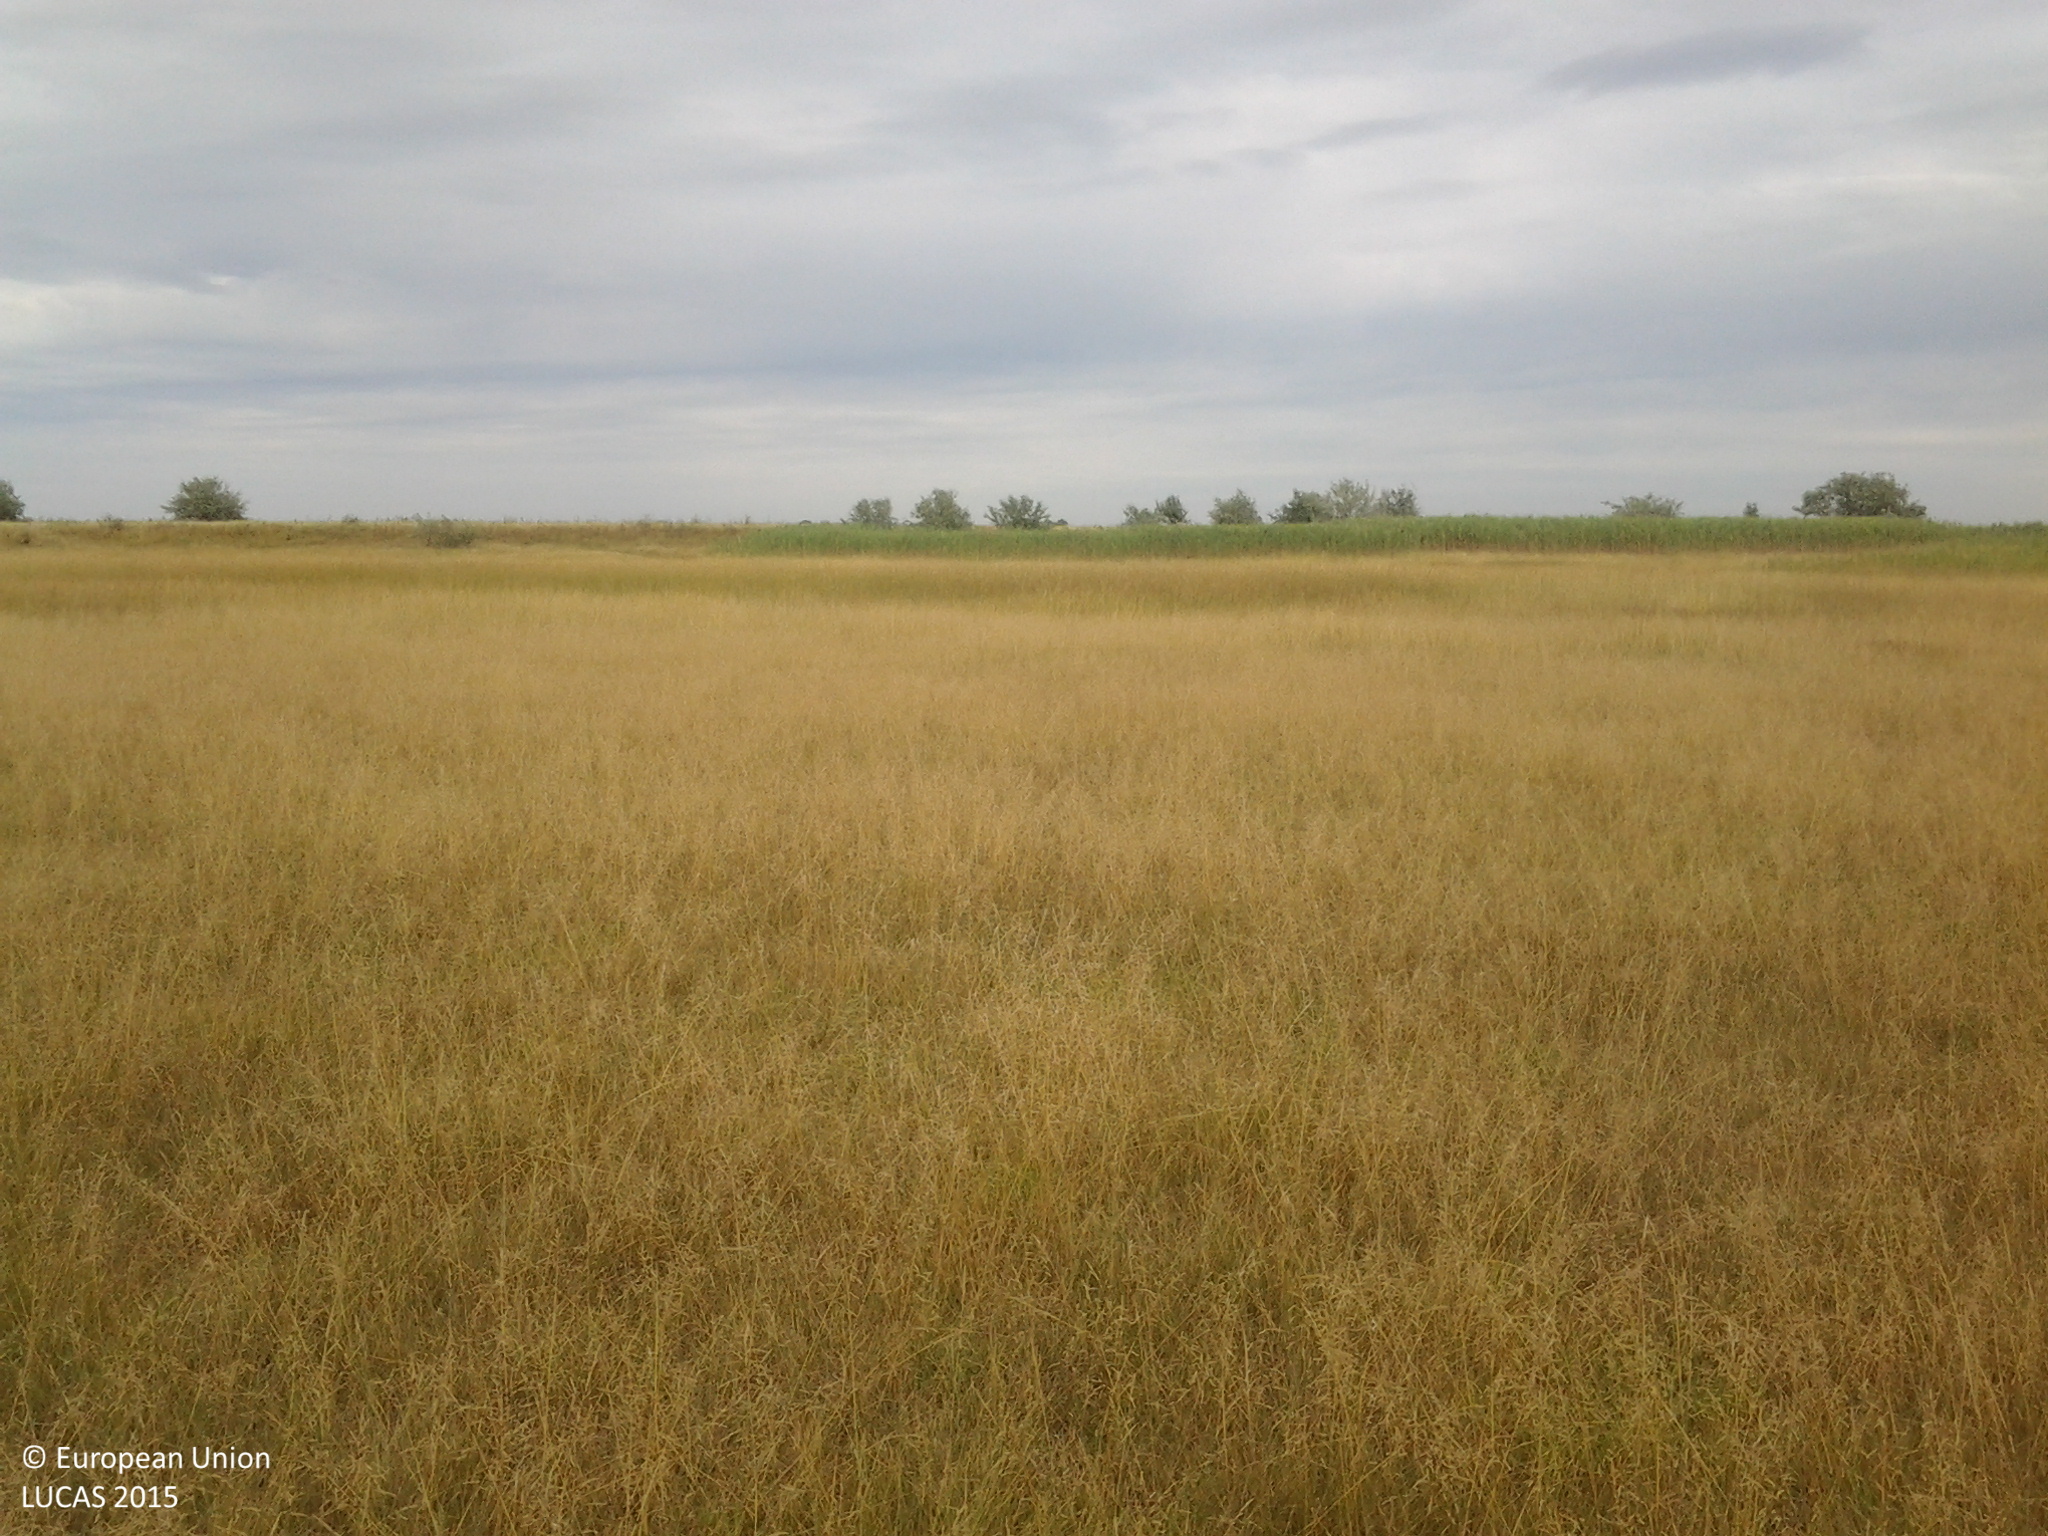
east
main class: Grassland
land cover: Grassland without tree/shrub cover
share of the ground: > 75 %
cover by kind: herbaceous plants 100 %
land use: Agriculture (excluding fallow land and kitchen gardens)
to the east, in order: Grassland without tree/shrub cover; Tracks; Grassland without tree/shrub cover; Tracks; Inland marshes; Grassland with sparse tree/shrub cover; Grassland without tree/shrub cover
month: July
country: HU
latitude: 46.6850
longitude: 19.1283
